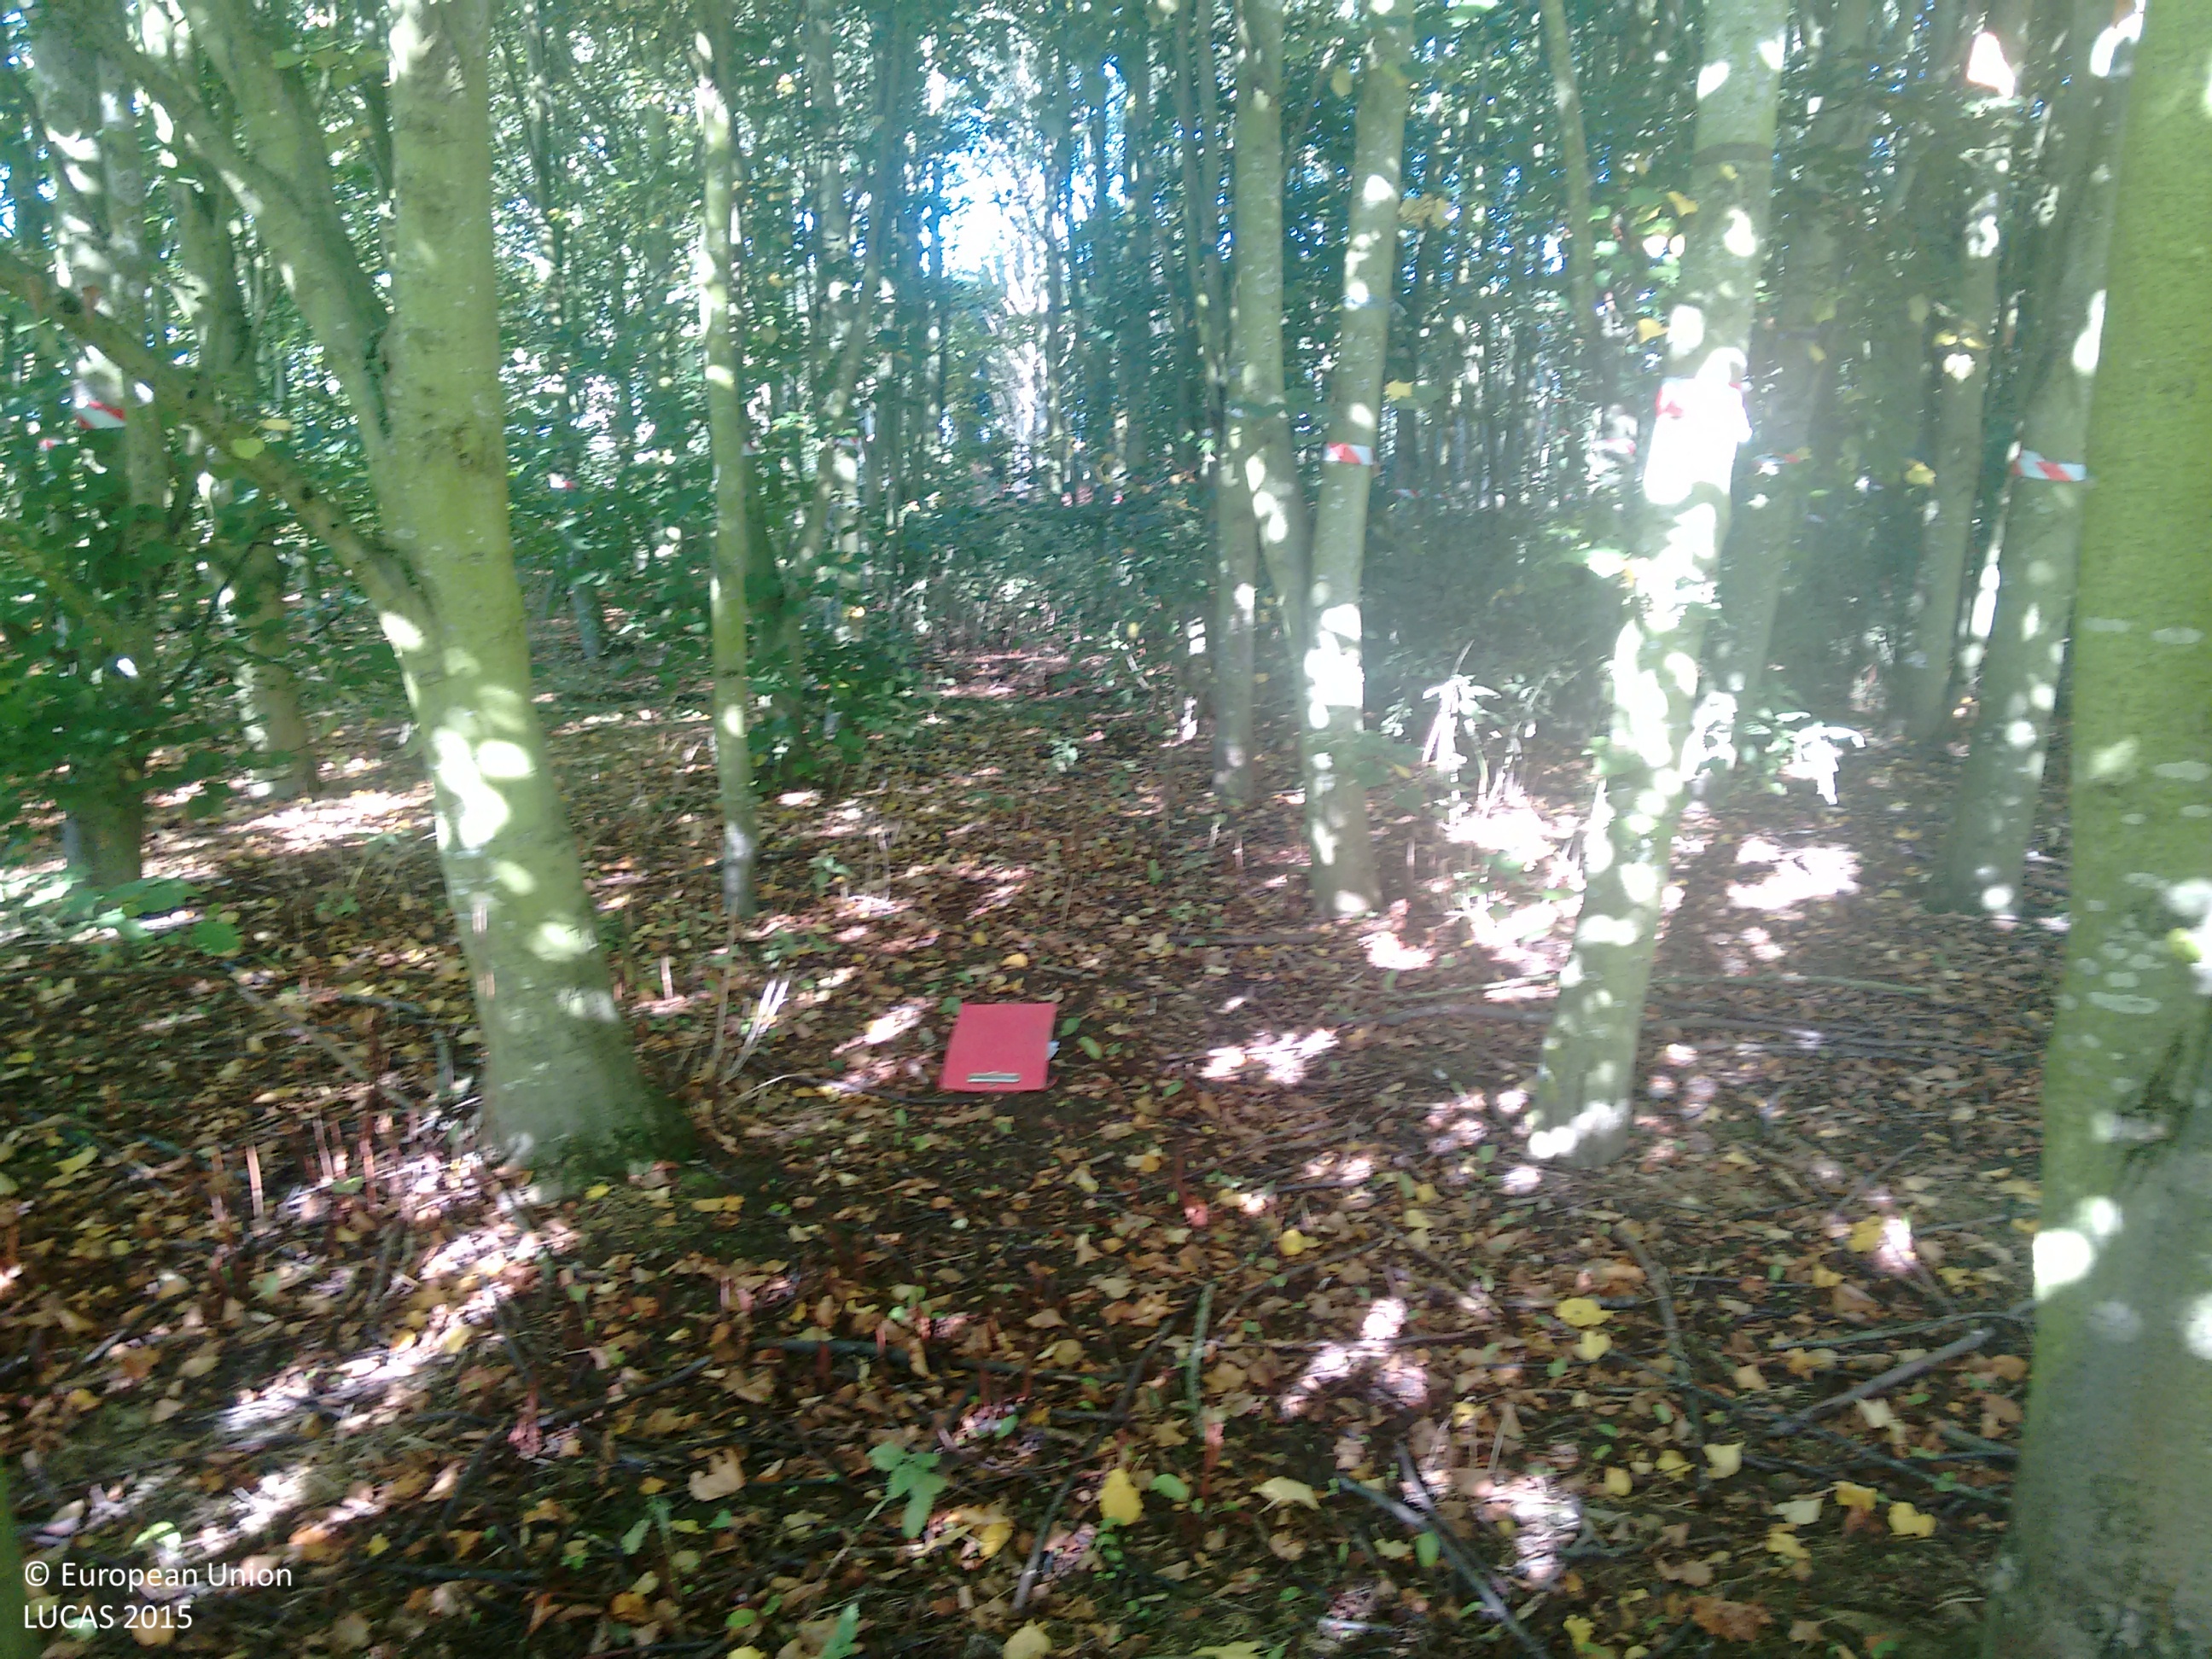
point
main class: Woodland
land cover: Broadleaved woodland
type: mesophytic deciduous forest
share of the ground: > 75 %
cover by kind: broadleaved forest trees 100 %
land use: Forestry
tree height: > 5 m
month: September
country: GB
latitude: 52.2411
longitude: -0.0354
